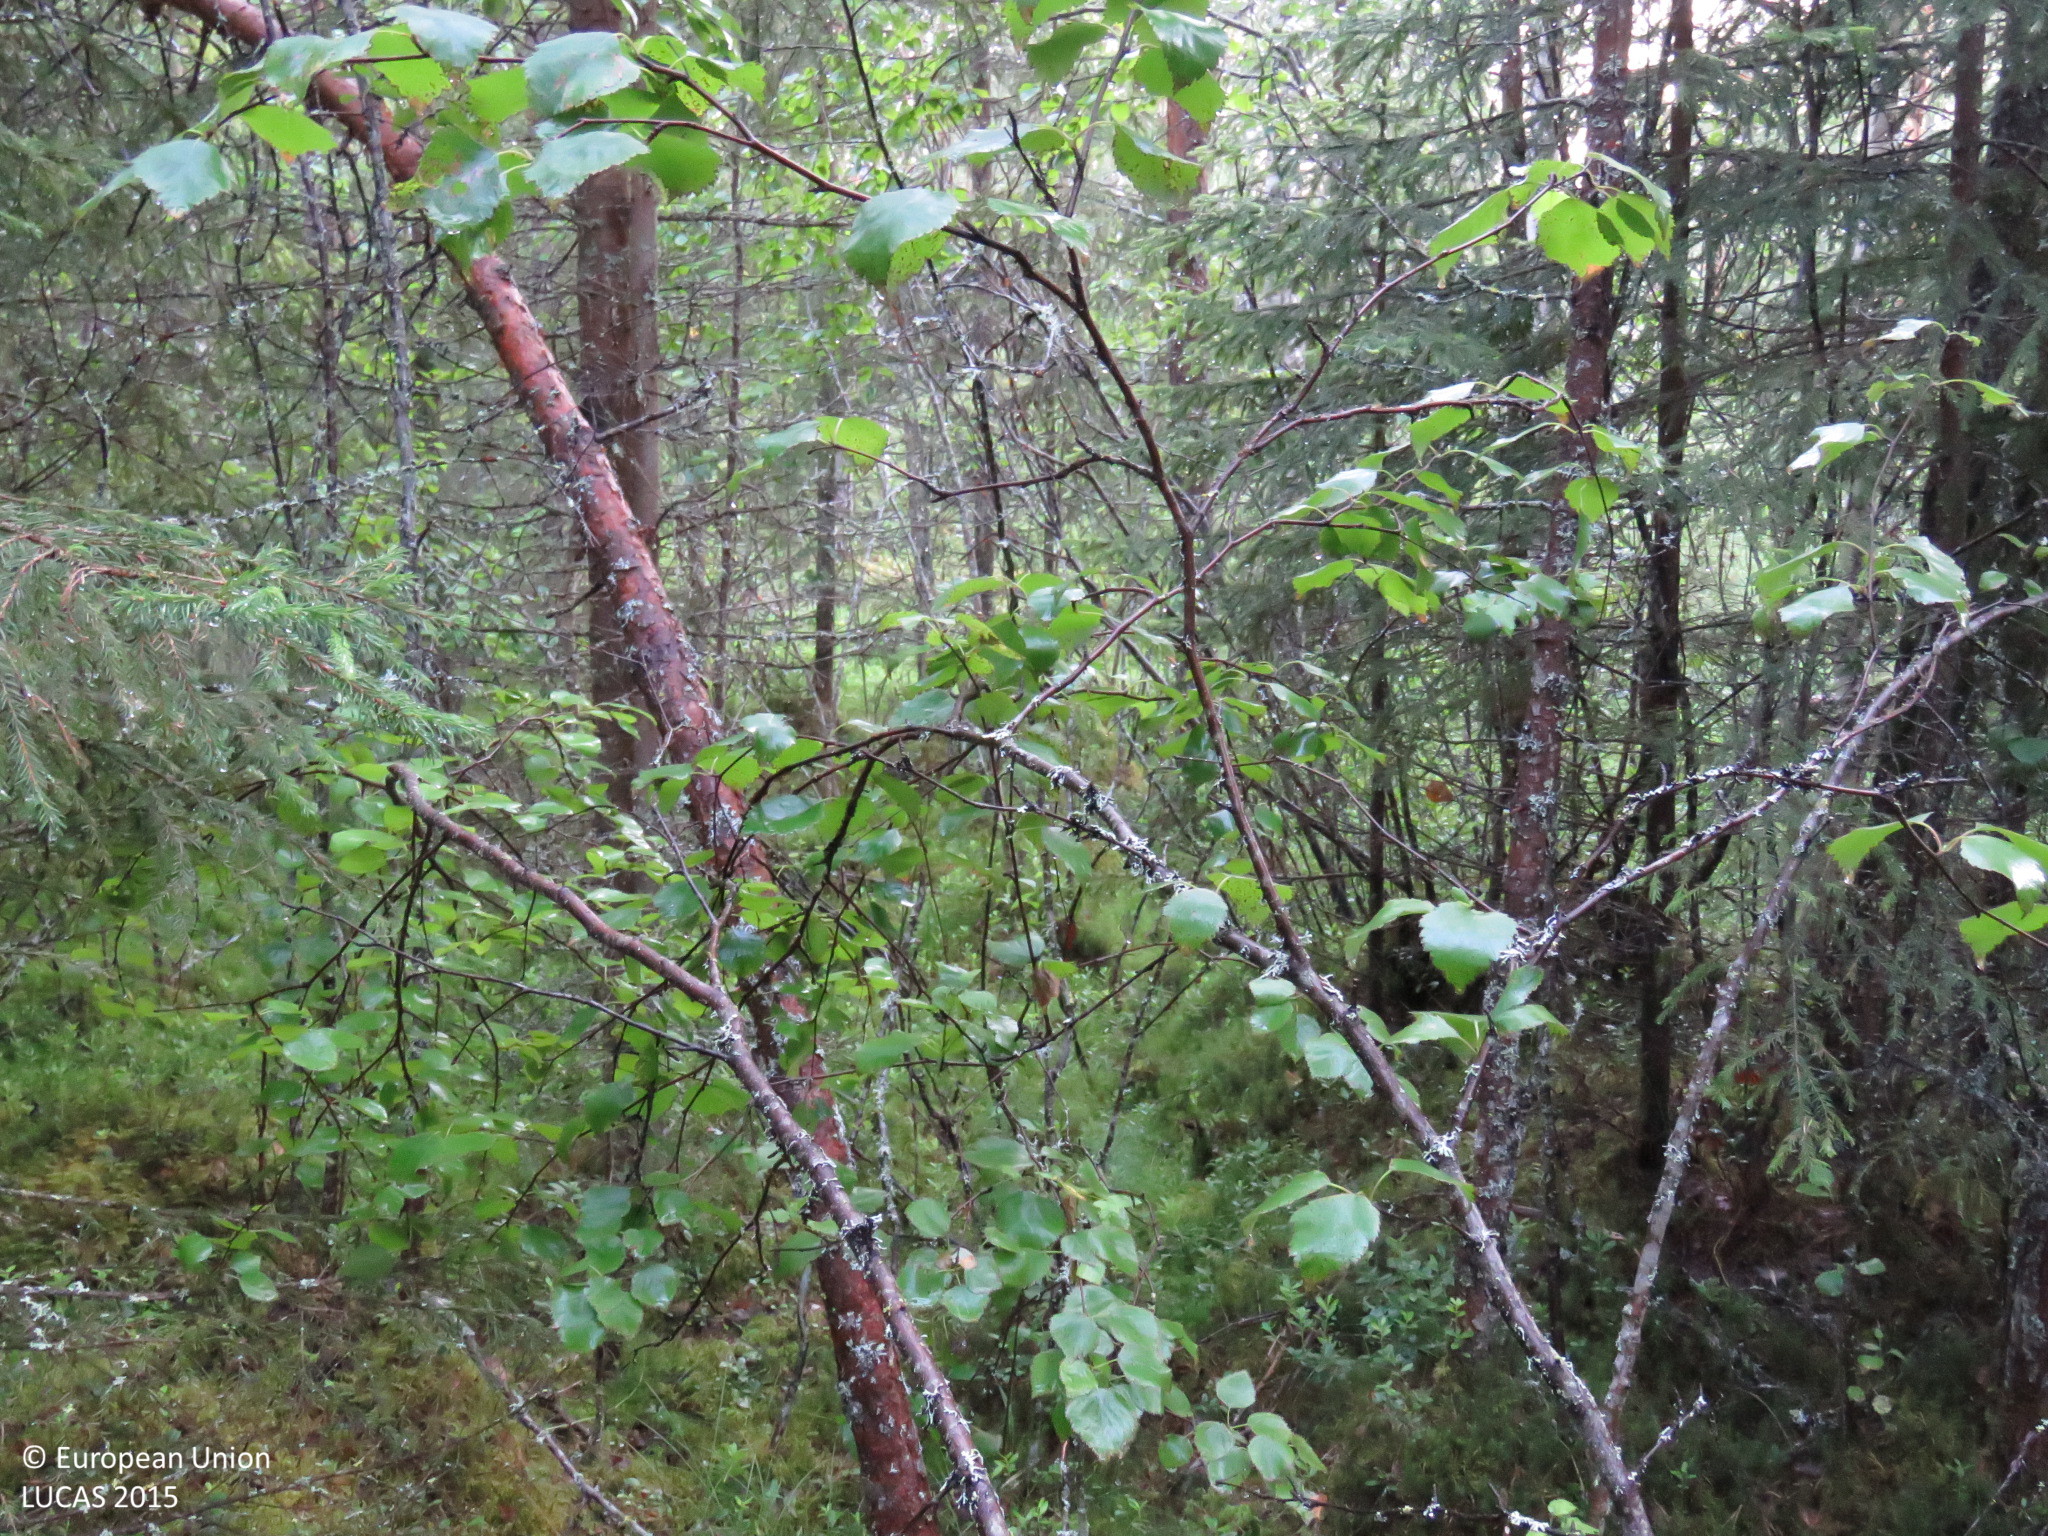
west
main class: Woodland
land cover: Spruce dominated mixed woodland
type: boreal forest
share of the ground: > 75 %
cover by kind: coniferous forest trees 65 %, broadleaved forest trees 25 %, shrubs 10 %
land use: Forestry
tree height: > 5 m
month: July
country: FI
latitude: 64.1592
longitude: 26.4654
